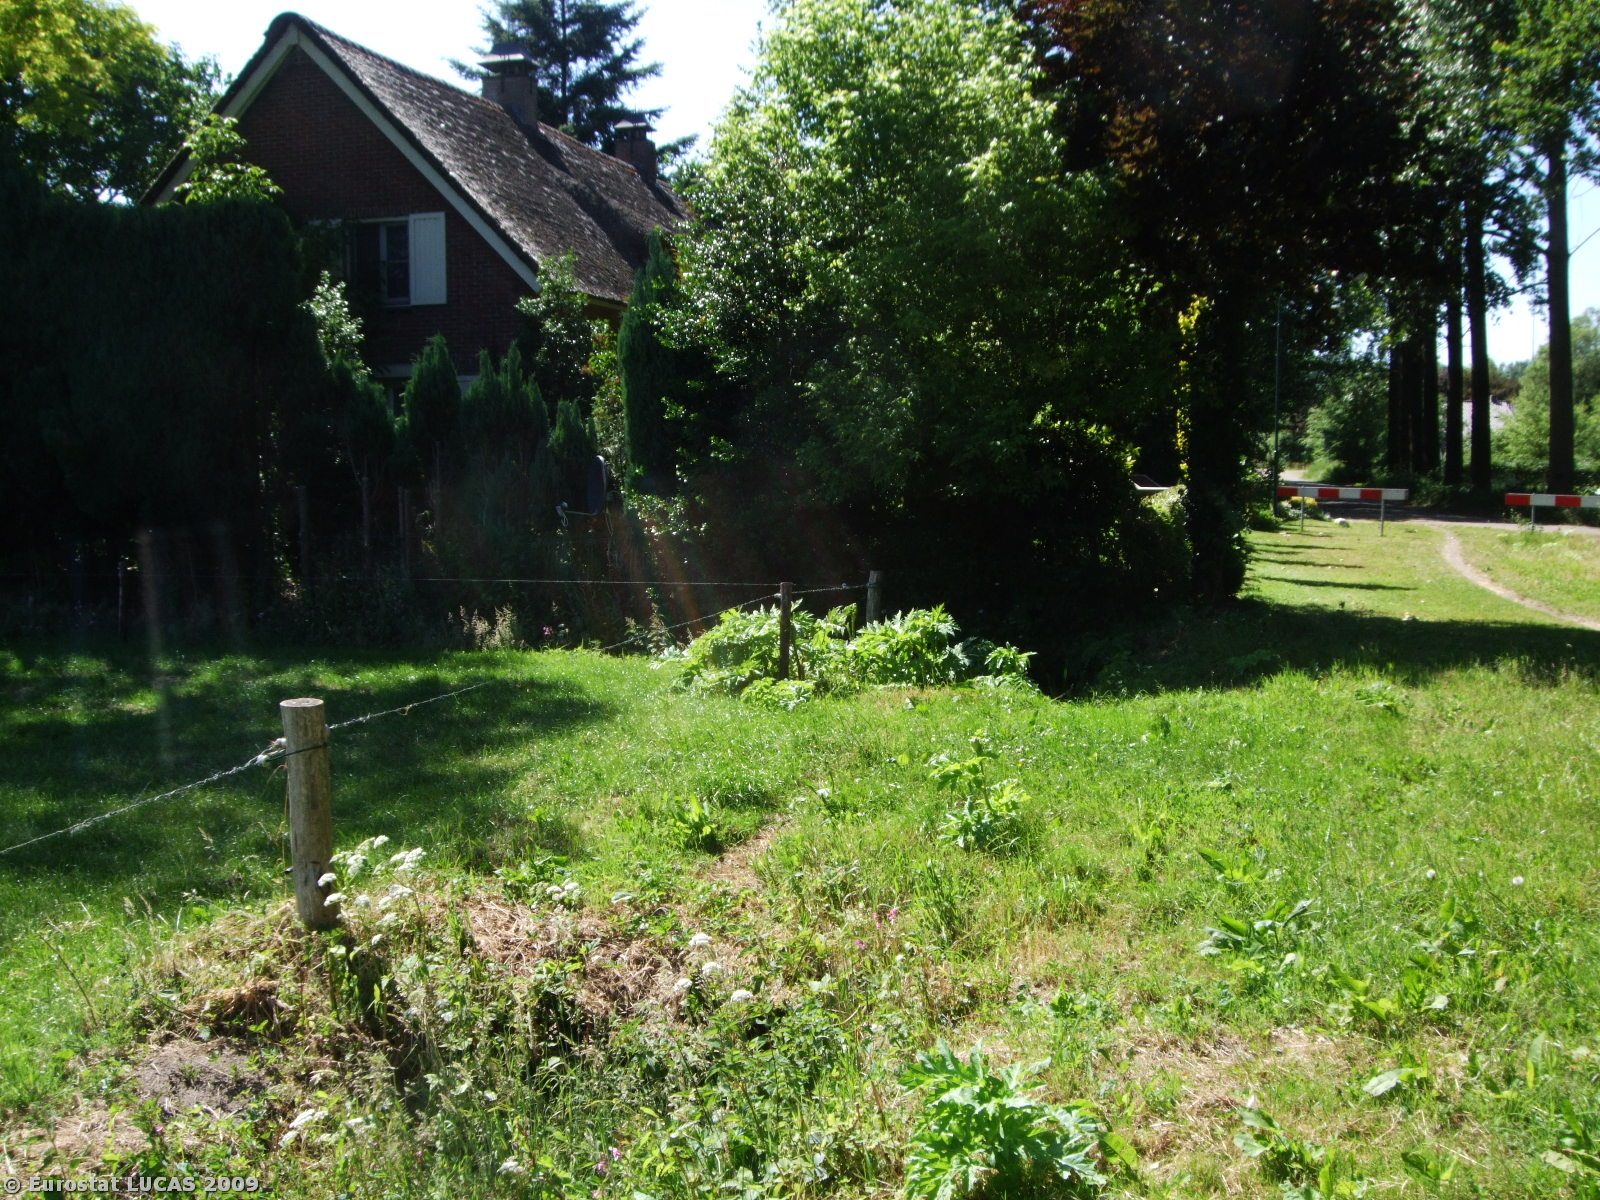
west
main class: Grassland
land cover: Grassland with sparse tree/shrub cover
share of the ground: > 75 %
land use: Road transport
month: June
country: NL
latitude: 51.5523
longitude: 5.4551
